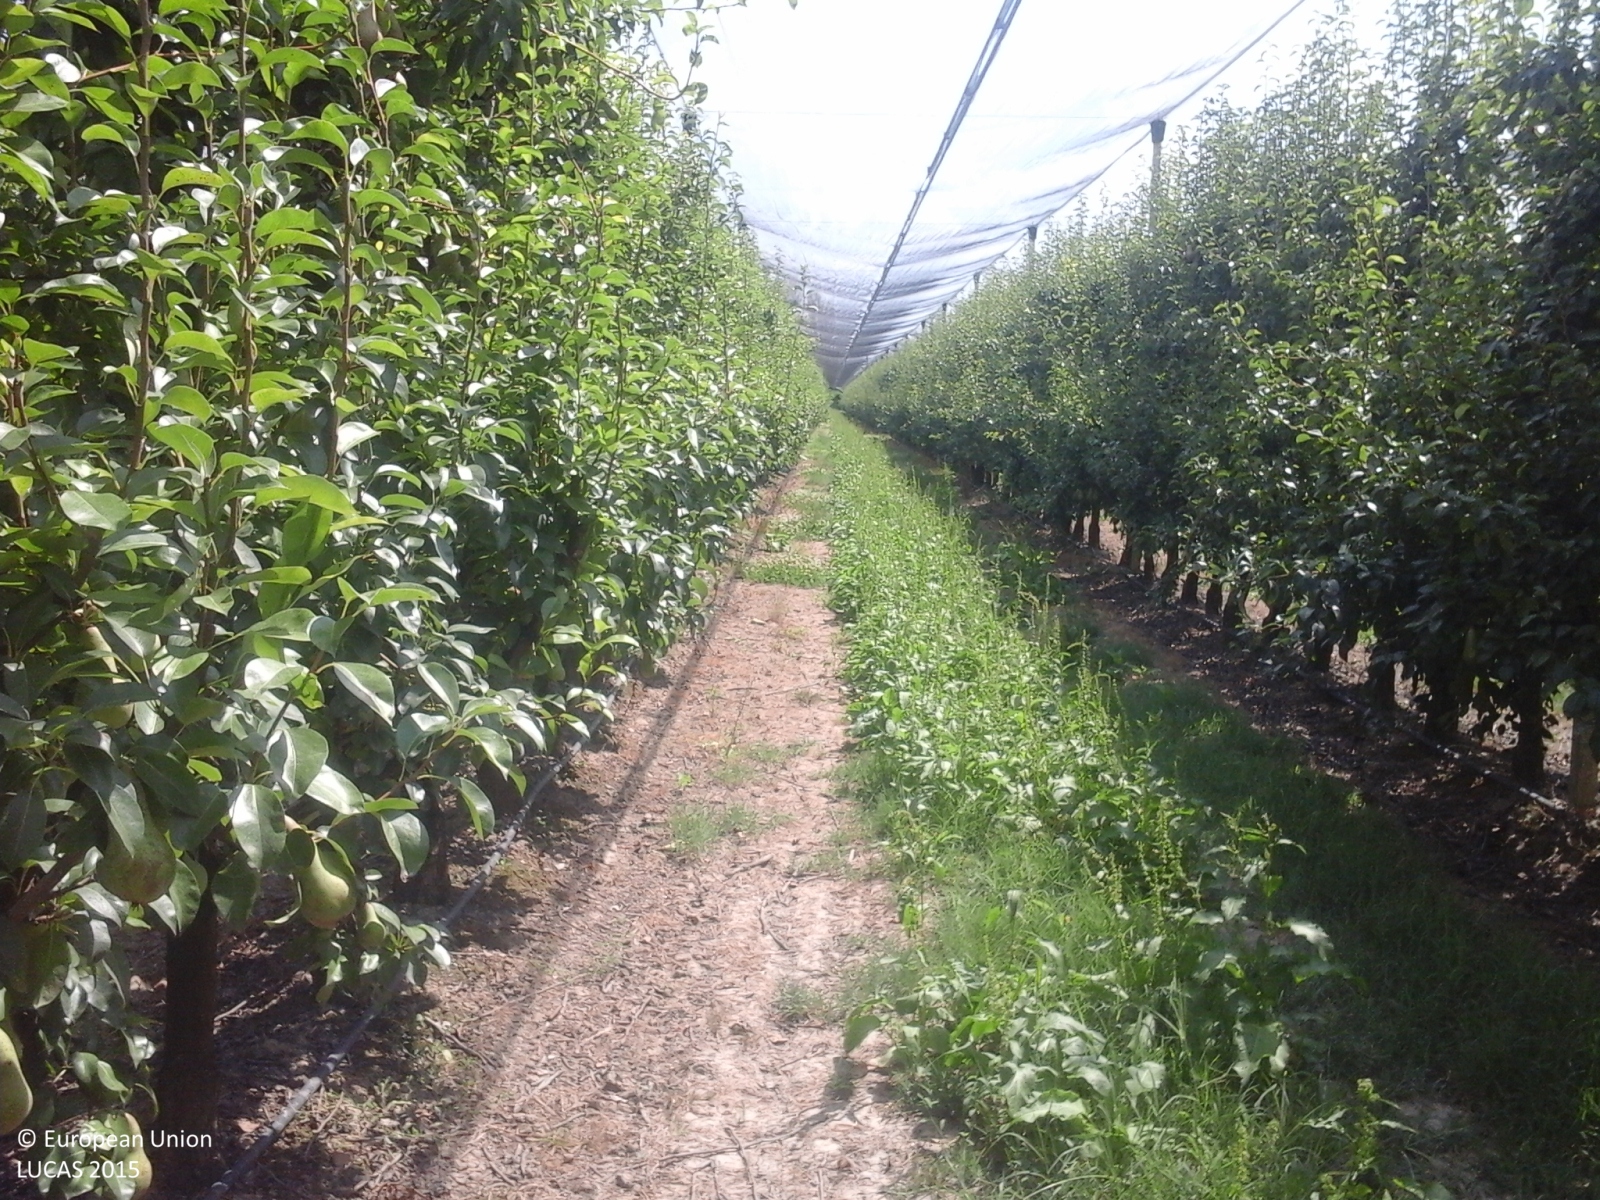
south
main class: Cropland
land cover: Pear fruit
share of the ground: > 75 %
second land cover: Grassland without tree/shrub cover
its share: > 75 %
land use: Agriculture (excluding fallow land and kitchen gardens)
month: June
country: IT
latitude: 44.8858
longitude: 11.0993
